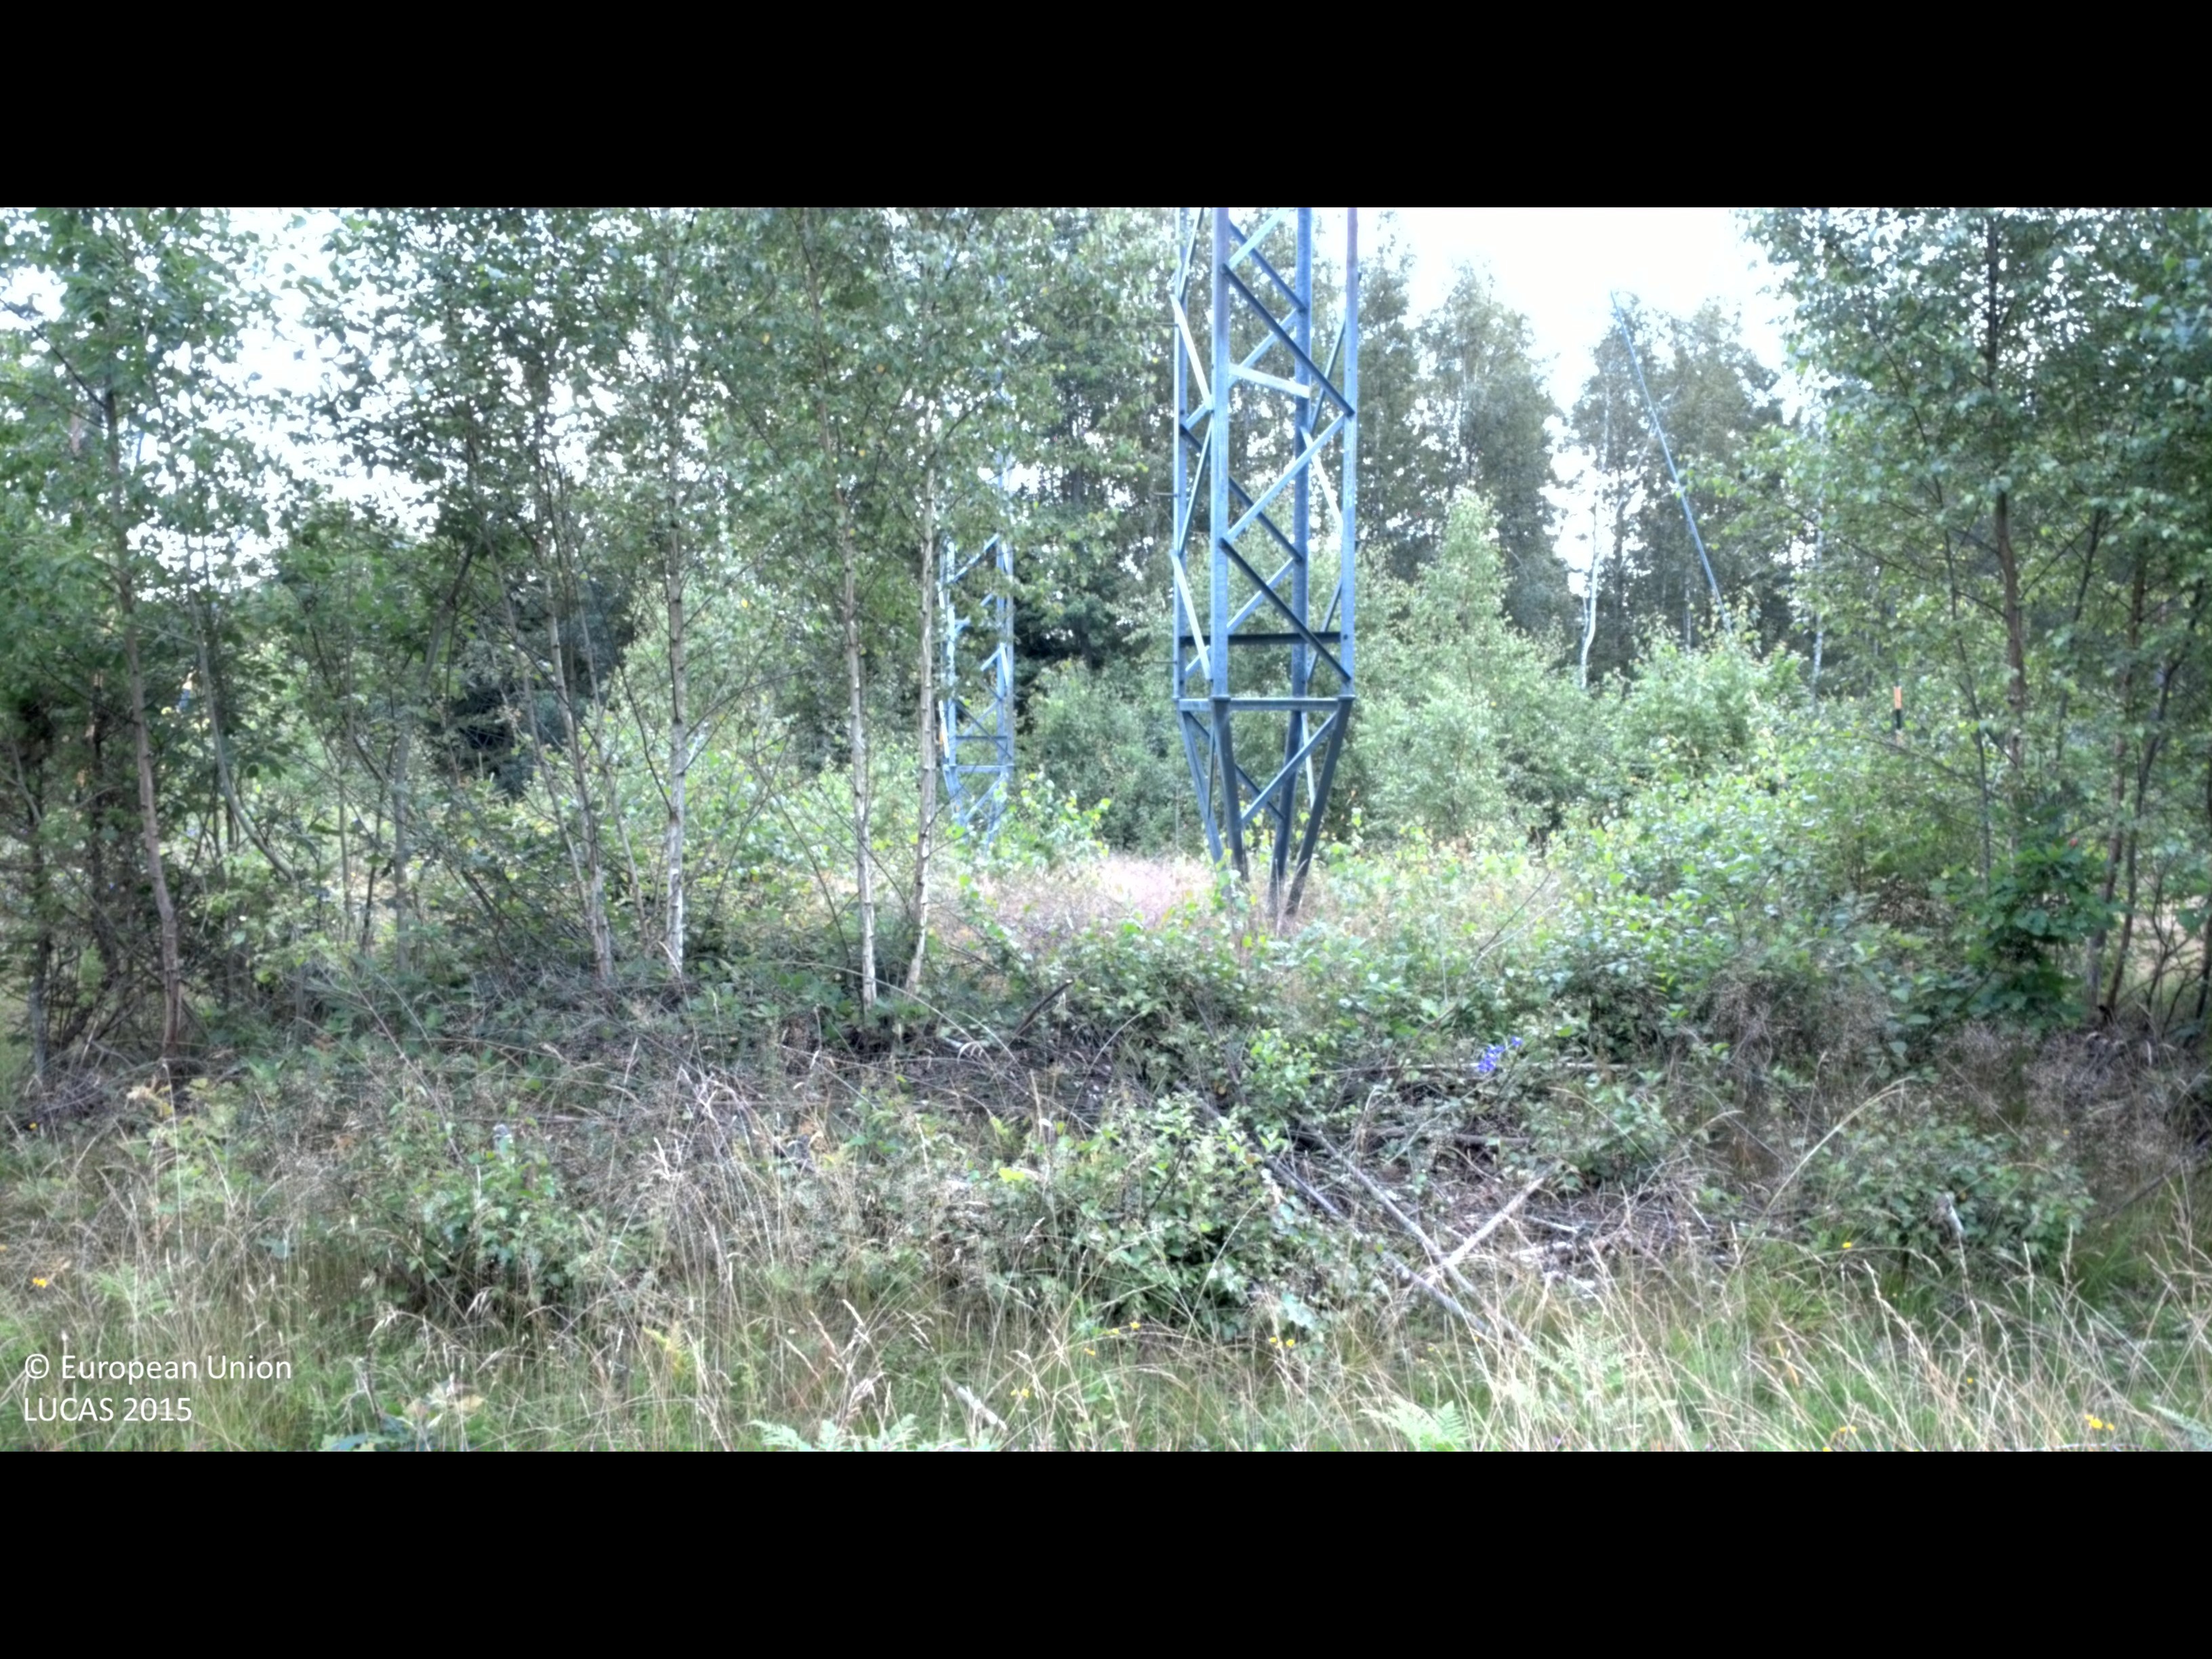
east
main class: Woodland
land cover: Broadleaved woodland
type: boreal forest
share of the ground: 25 - 50 %
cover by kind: herbaceous plants 55 %, broadleaved forest trees 35 %, shrubs 10 %
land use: Forestry
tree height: < 5 m
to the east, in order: Broadleaved woodland; Electric lines; Broadleaved woodland; Spruce dominated mixed woodland; Grass margins; Paved roads, cycling and walking lanes; Broadleaved woodland; Grassland without tree/shrub cover; Shrubland with sparse tree cover; Spruce dominated coniferous woodland; Tracks; Spruce dominated coniferous woodland
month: July
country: SE
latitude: 57.8786
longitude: 16.1857
